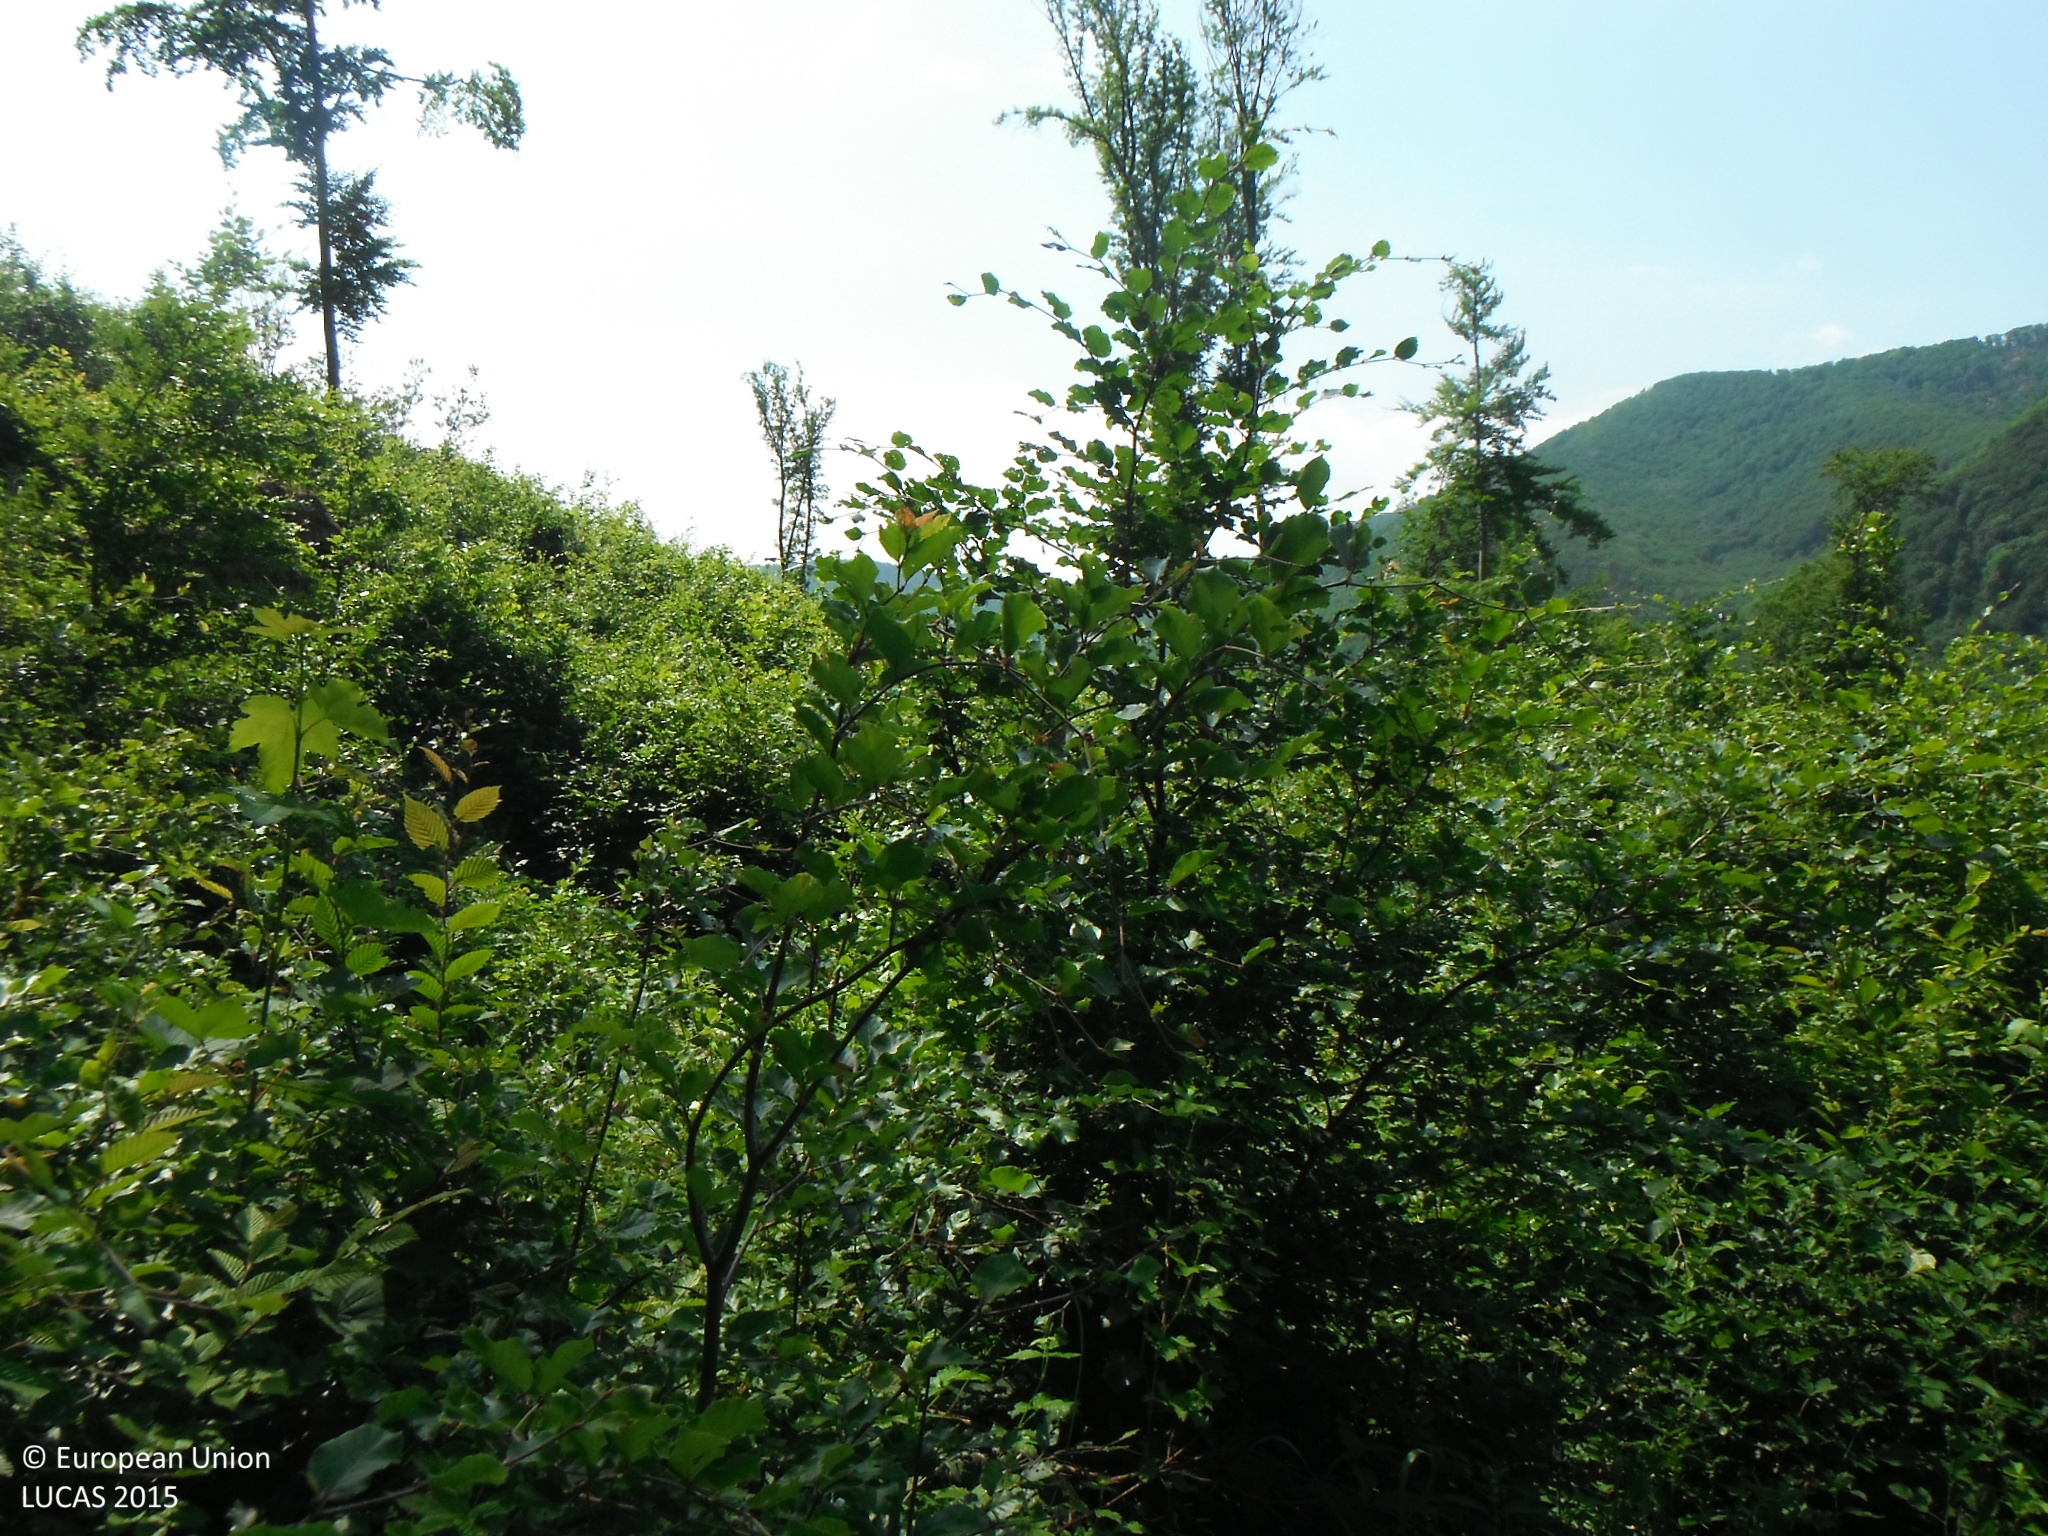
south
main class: Woodland
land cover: Broadleaved woodland
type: beech forest
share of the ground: 50 - 75 %
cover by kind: broadleaved forest trees 60 %, herbaceous plants 40 %
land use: Forestry
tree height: < 5 m
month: June
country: SK
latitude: 48.8723
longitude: 21.1553
